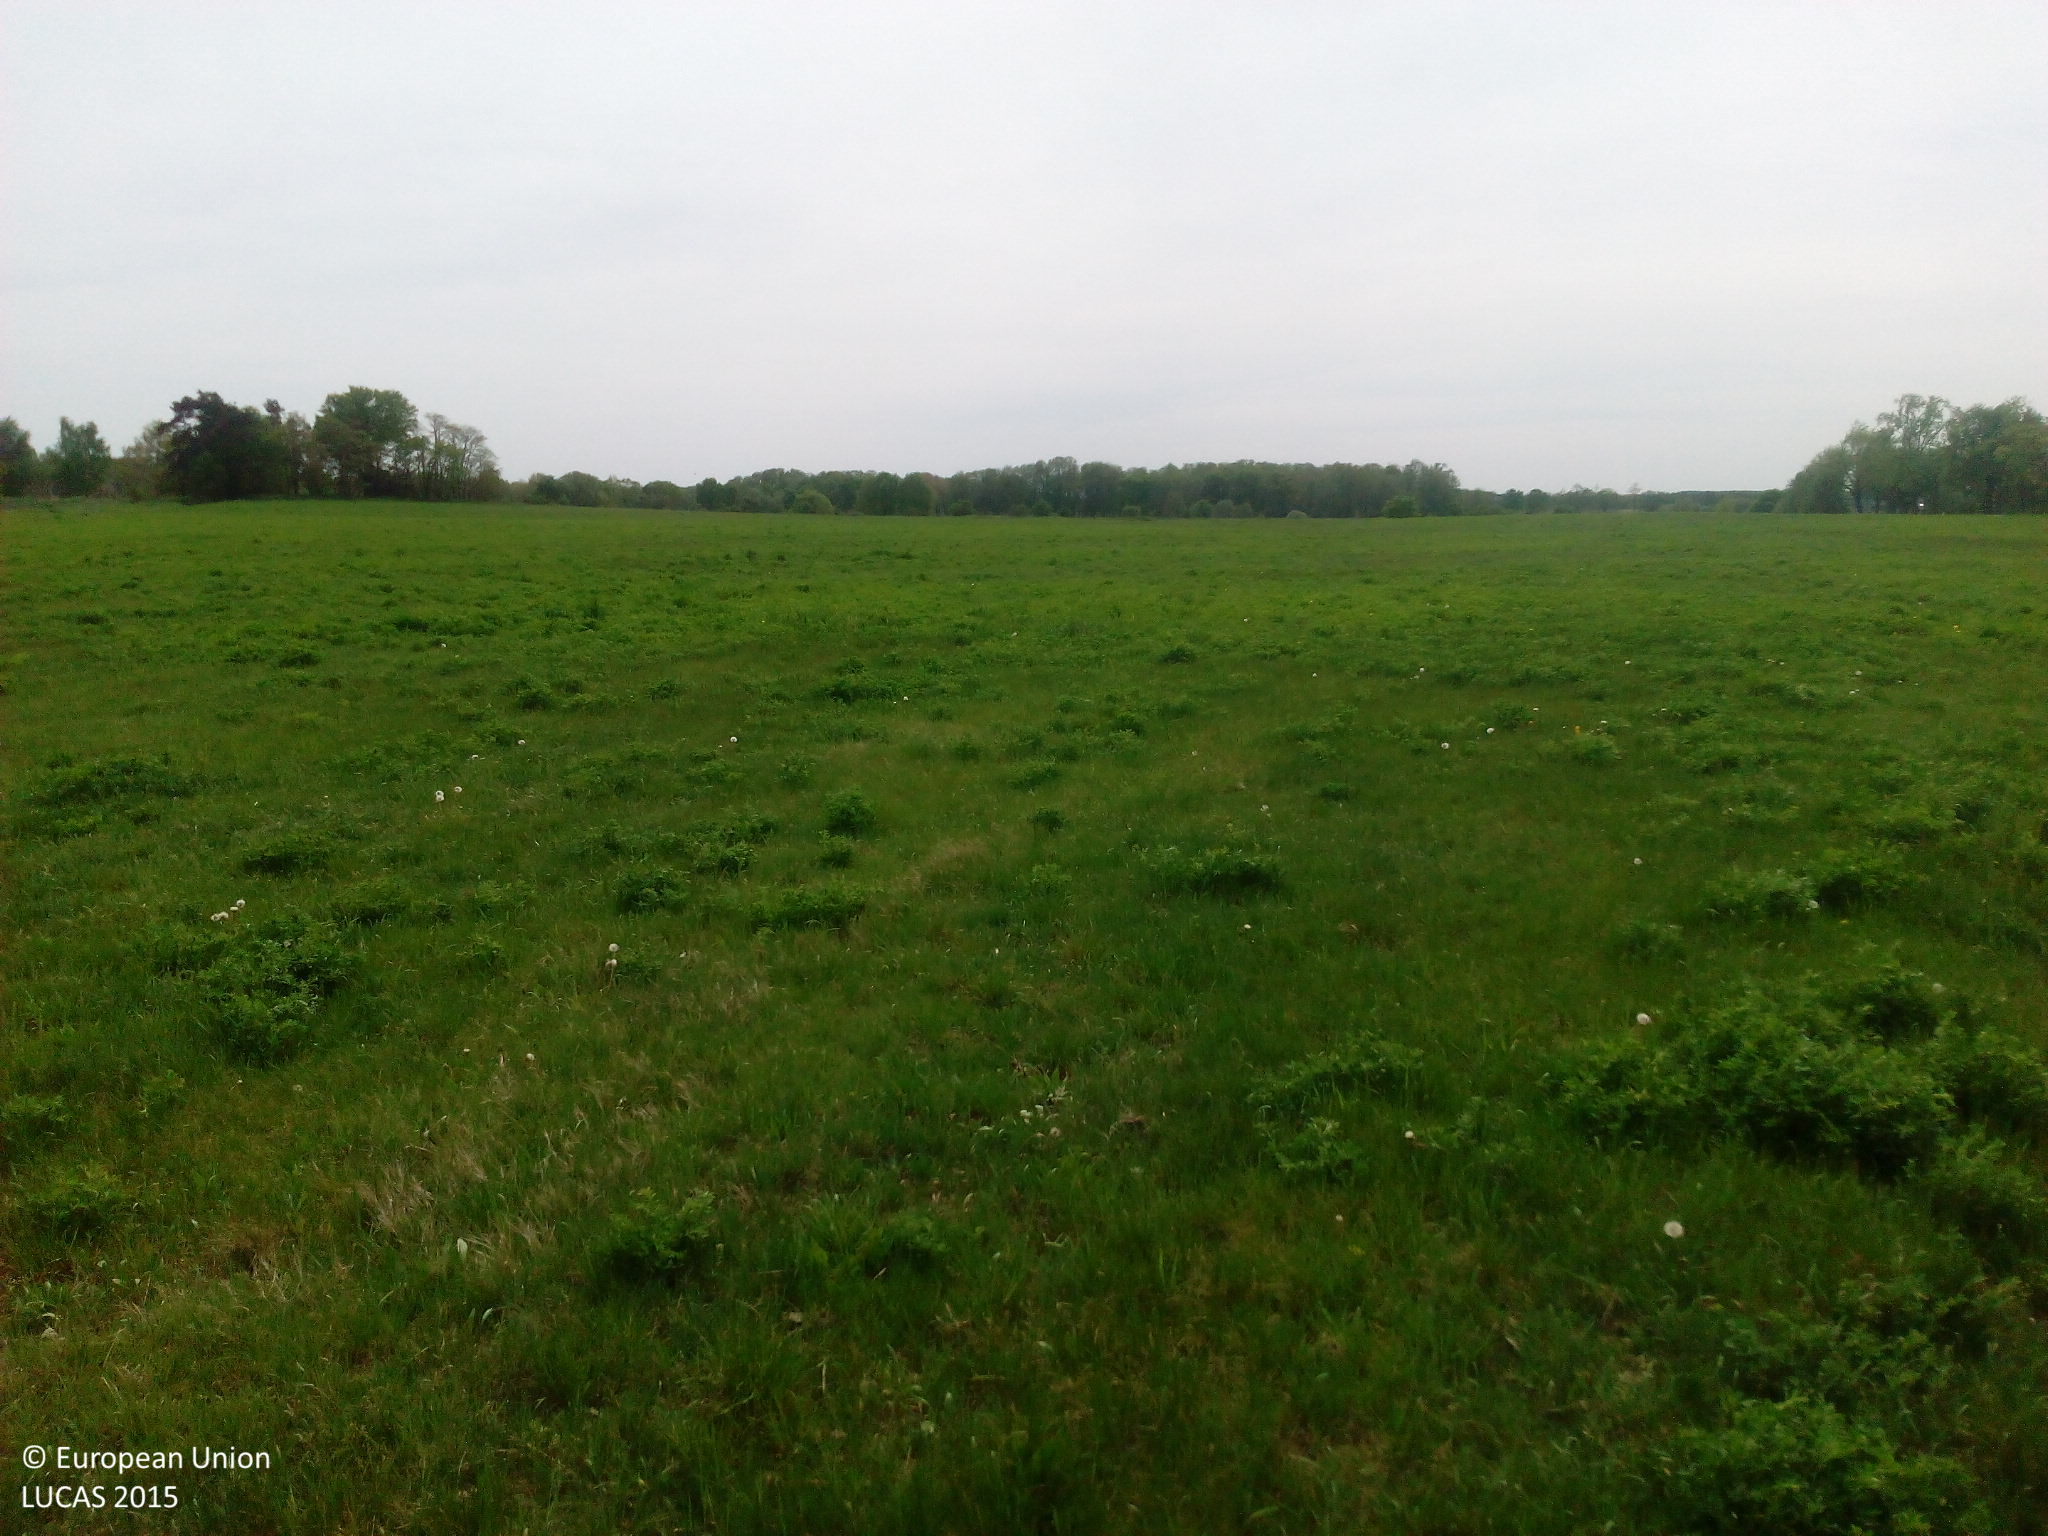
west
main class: Grassland
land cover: Grassland without tree/shrub cover
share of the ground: > 75 %
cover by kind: herbaceous plants 100 %
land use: Agriculture (excluding fallow land and kitchen gardens)
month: May
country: DE
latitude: 52.3348
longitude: 13.1846
